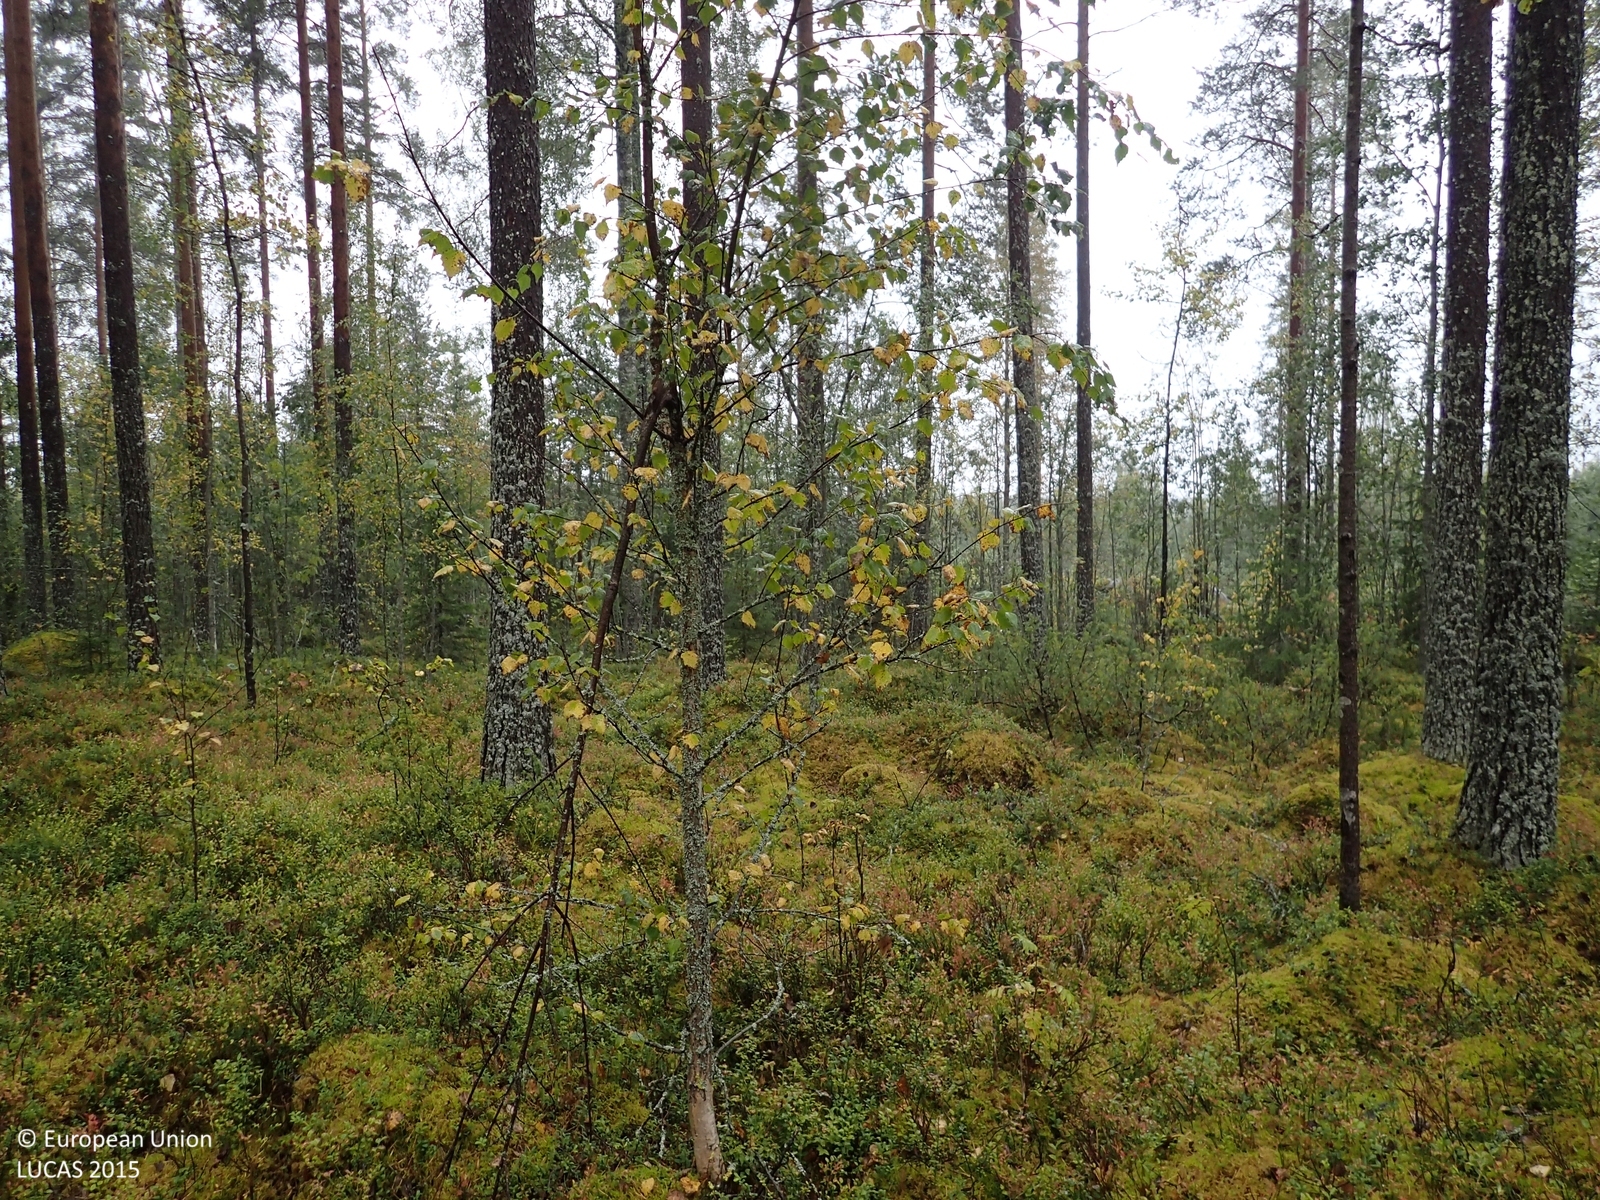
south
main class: Woodland
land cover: Pine dominated mixed woodland
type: boreal forest
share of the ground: 50 - 75 %
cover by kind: coniferous forest trees 55 %, broadleaved forest trees 20 %, shrubs 20 %, lichens and mosses 5 %
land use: Forestry
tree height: > 5 m
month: September
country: FI
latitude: 63.2270
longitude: 25.2817
